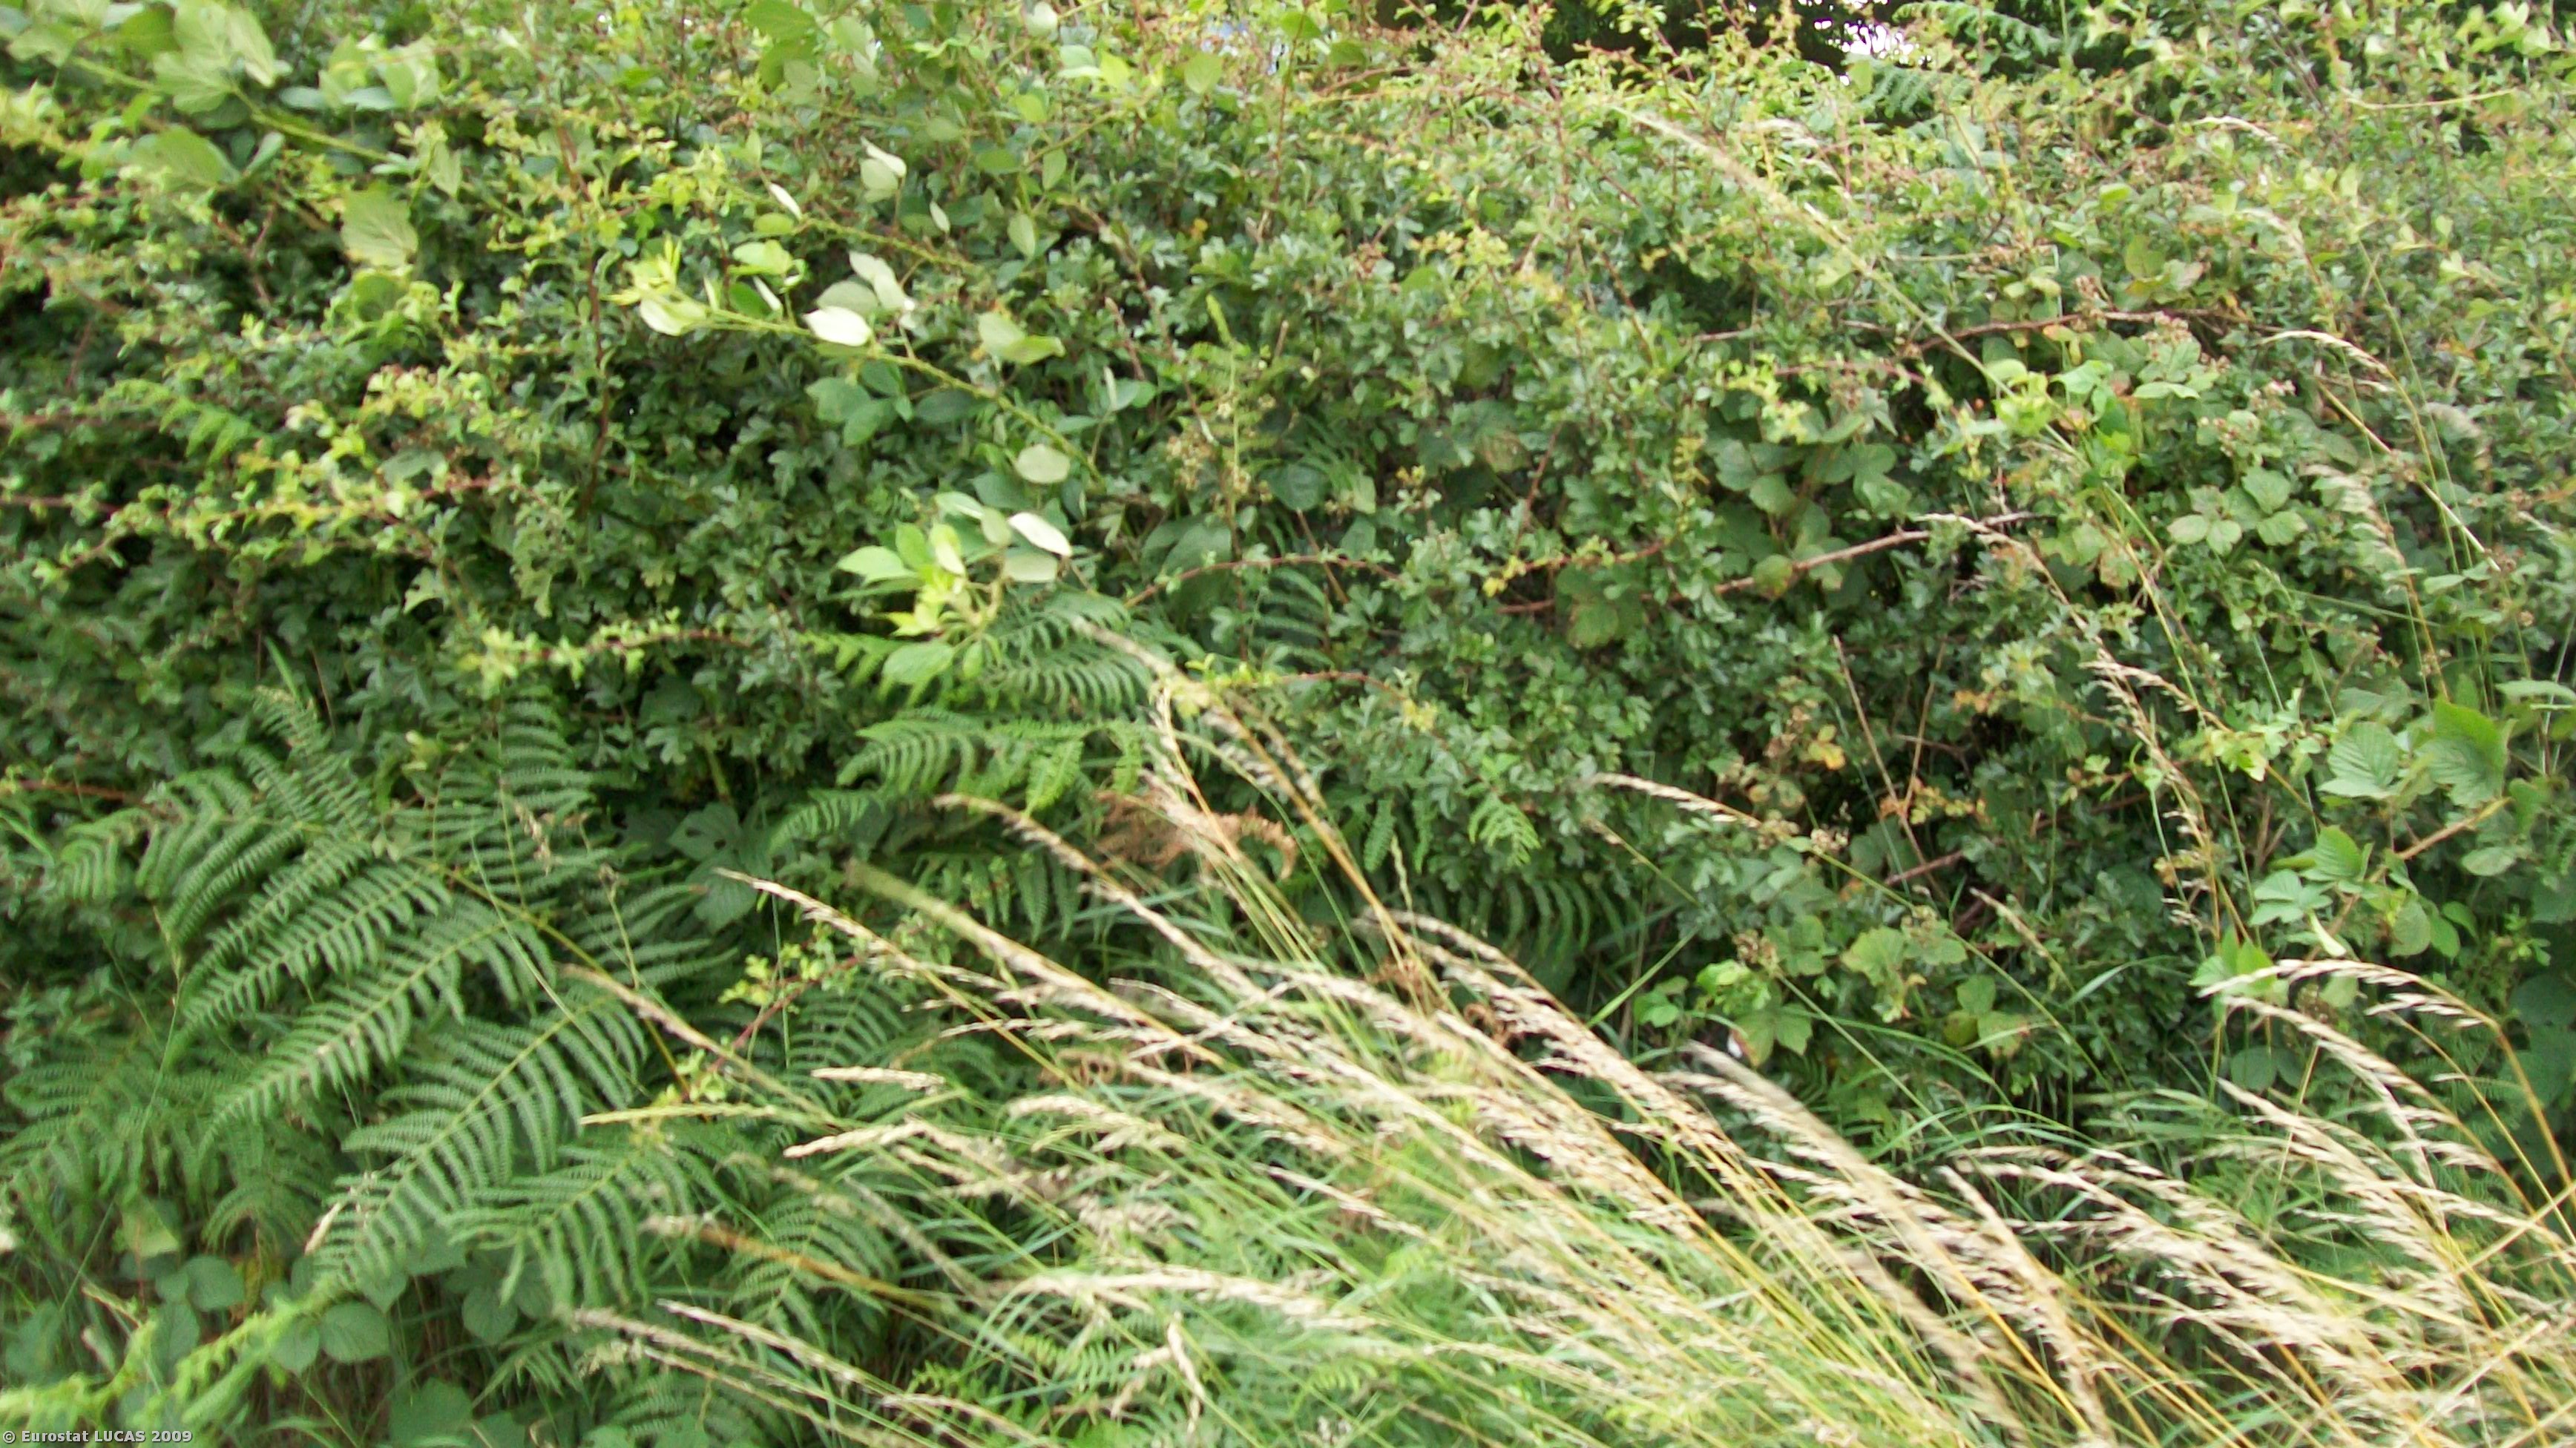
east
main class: Cropland
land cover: Common wheat
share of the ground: > 75 %
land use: Agriculture (excluding fallow land and kitchen gardens)
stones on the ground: 10 - 25 %
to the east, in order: Common wheat; Electric lines; Grass margins; Managed hedges; Grass margins; Paved roads, cycling and walking lanes; Grass margins; Abandoned hedges; Grassland without tree/shrub cover; Fences; Broadleaved woodland
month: July
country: GB
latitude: 53.0682
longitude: -1.1342
